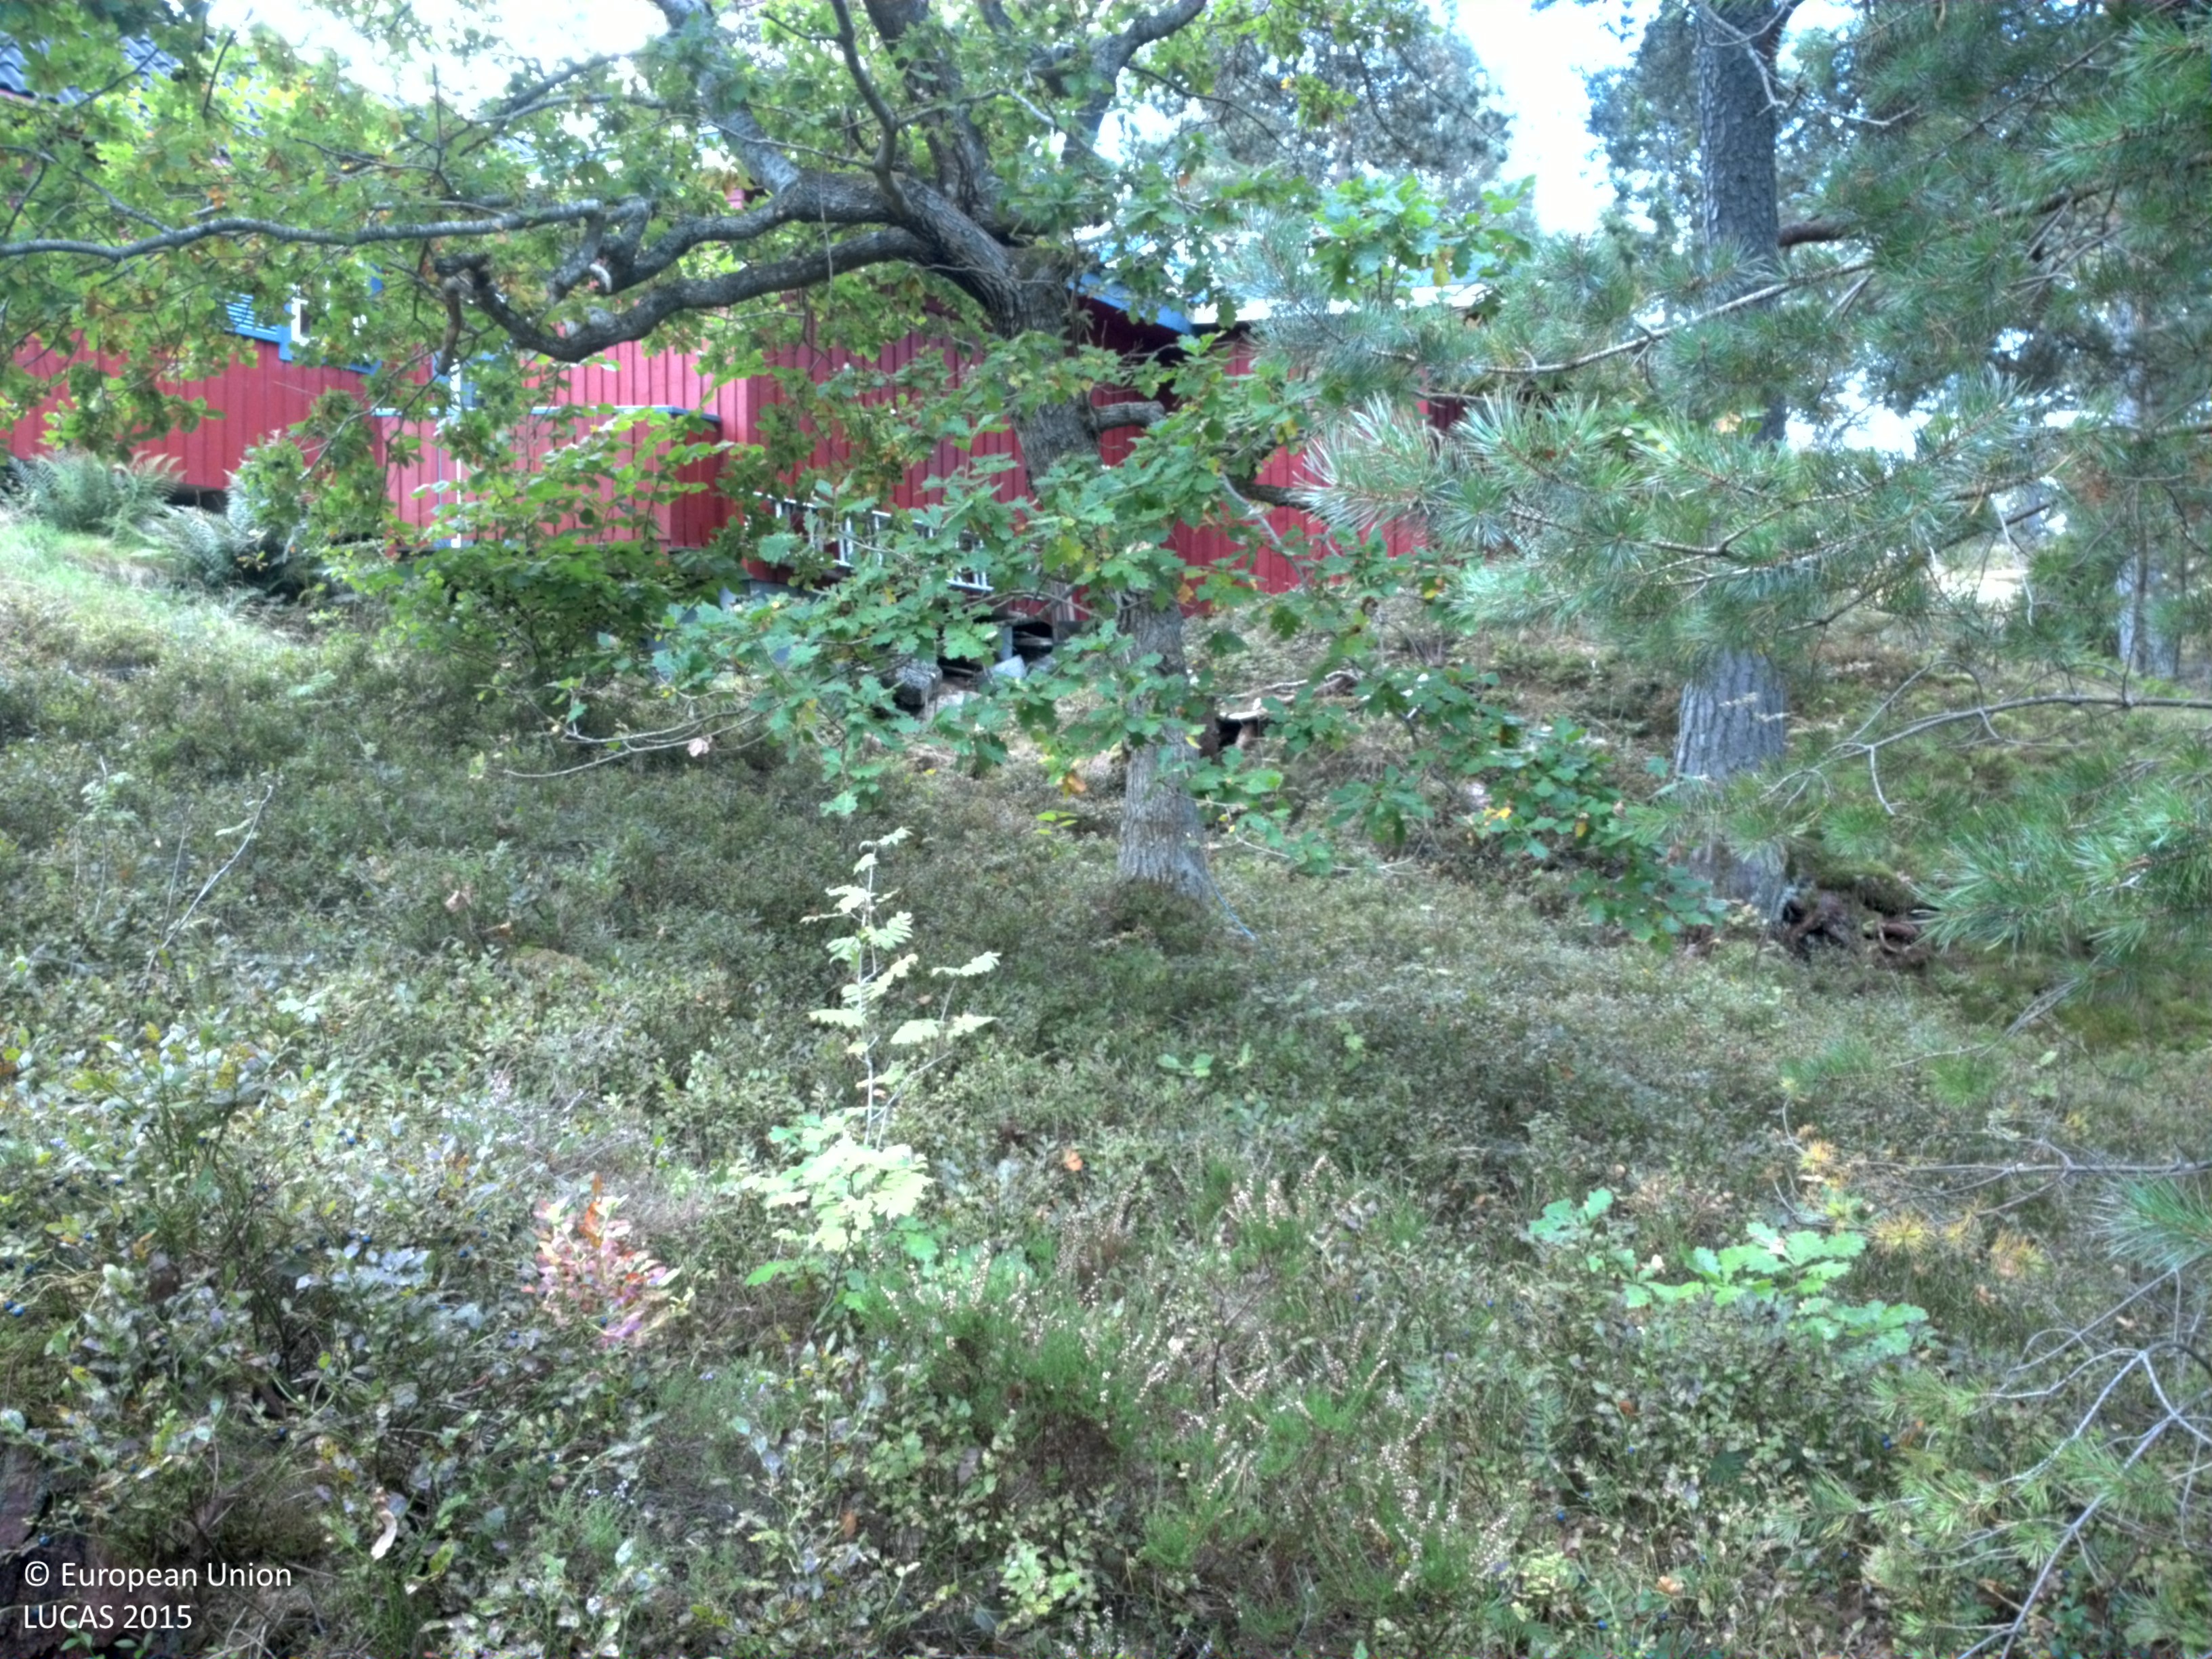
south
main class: Woodland
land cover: Pine dominated mixed woodland
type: boreal forest
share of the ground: < 10 %
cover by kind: lichens and mosses 35 %, consolidated bare surface 20 %, coniferous forest trees 15 %, shrubs 15 %, herbaceous plants 10 %, broadleaved forest trees 5 %
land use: Residential
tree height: > 5 m
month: September
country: SE
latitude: 59.3695
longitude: 18.6768
